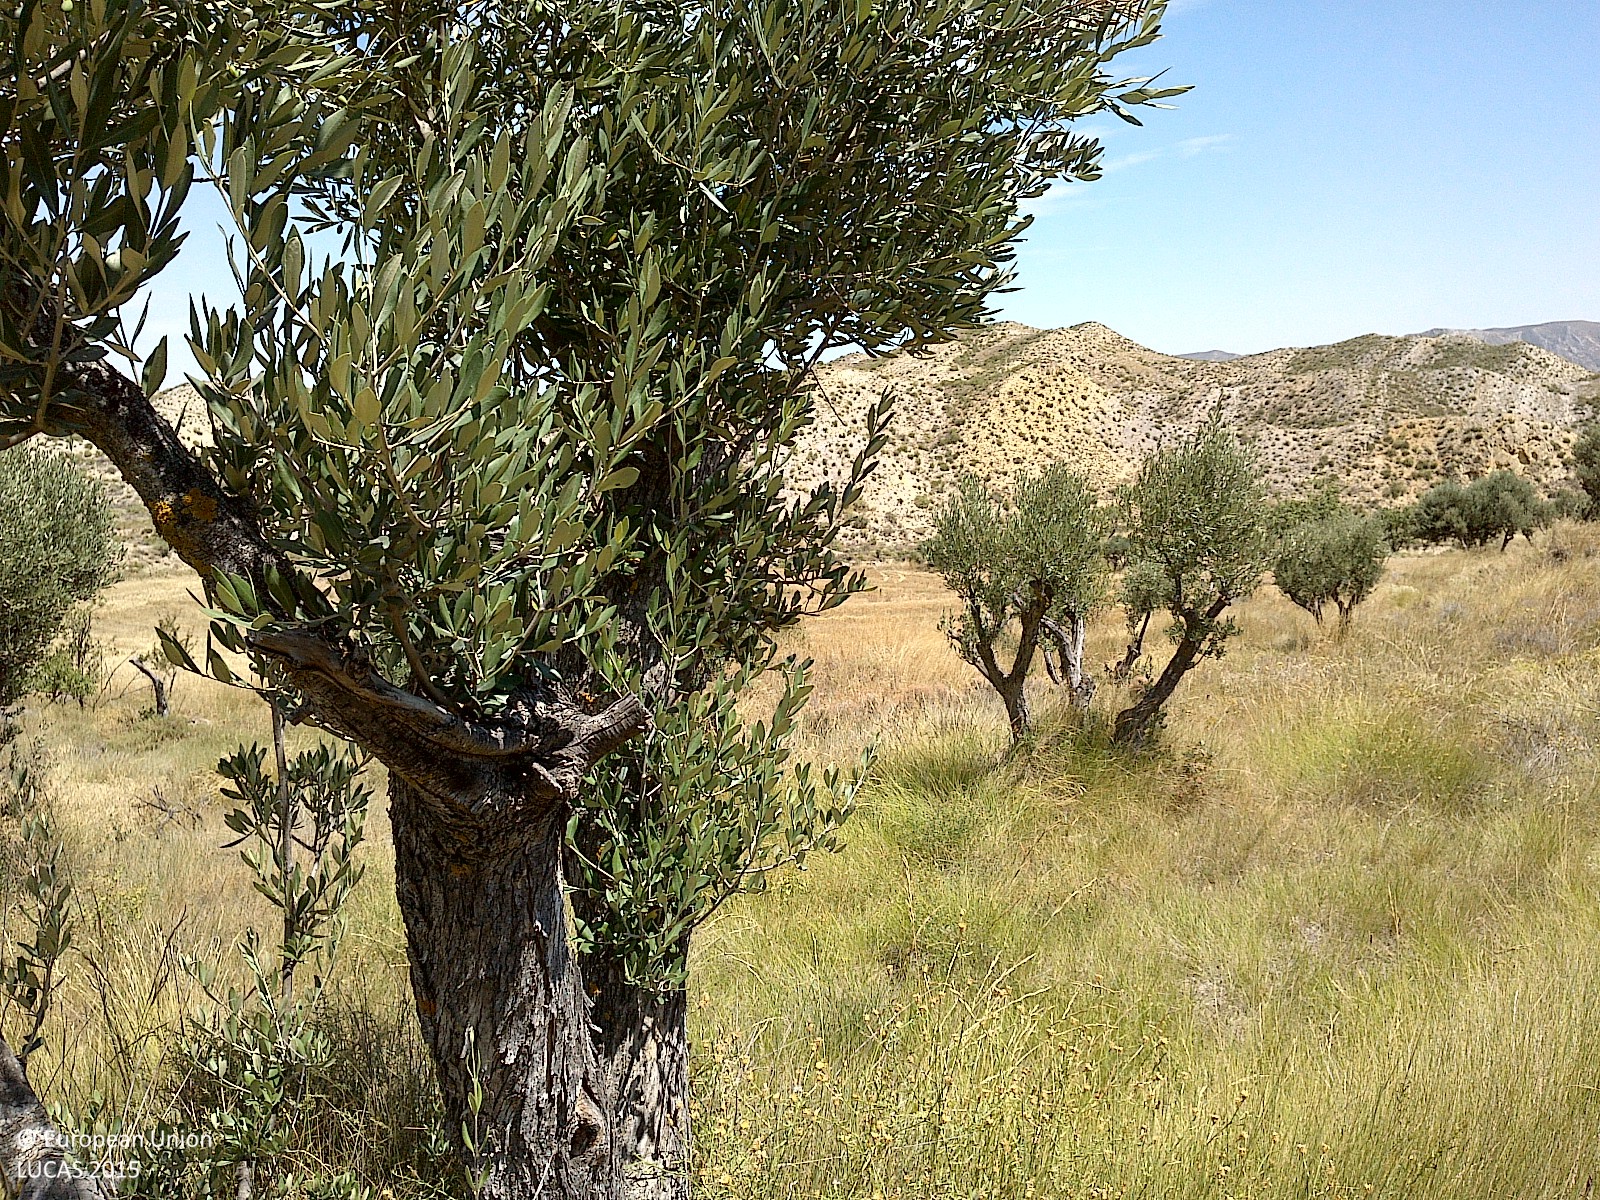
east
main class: Cropland
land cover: Olive groves
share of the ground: 10 - 25 %
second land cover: Grassland without tree/shrub cover
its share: > 75 %
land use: Agriculture (excluding fallow land and kitchen gardens)
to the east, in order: Olive groves; Grassland without tree/shrub cover; Nuts trees; Spontaneously vegetated surfaces; Common wheat; Grass margins; Common wheat; Grass margins; Common wheat; Olive groves; Dry stone walls; Shrubland without tree cover
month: July
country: ES
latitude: 41.9721
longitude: -2.0182
